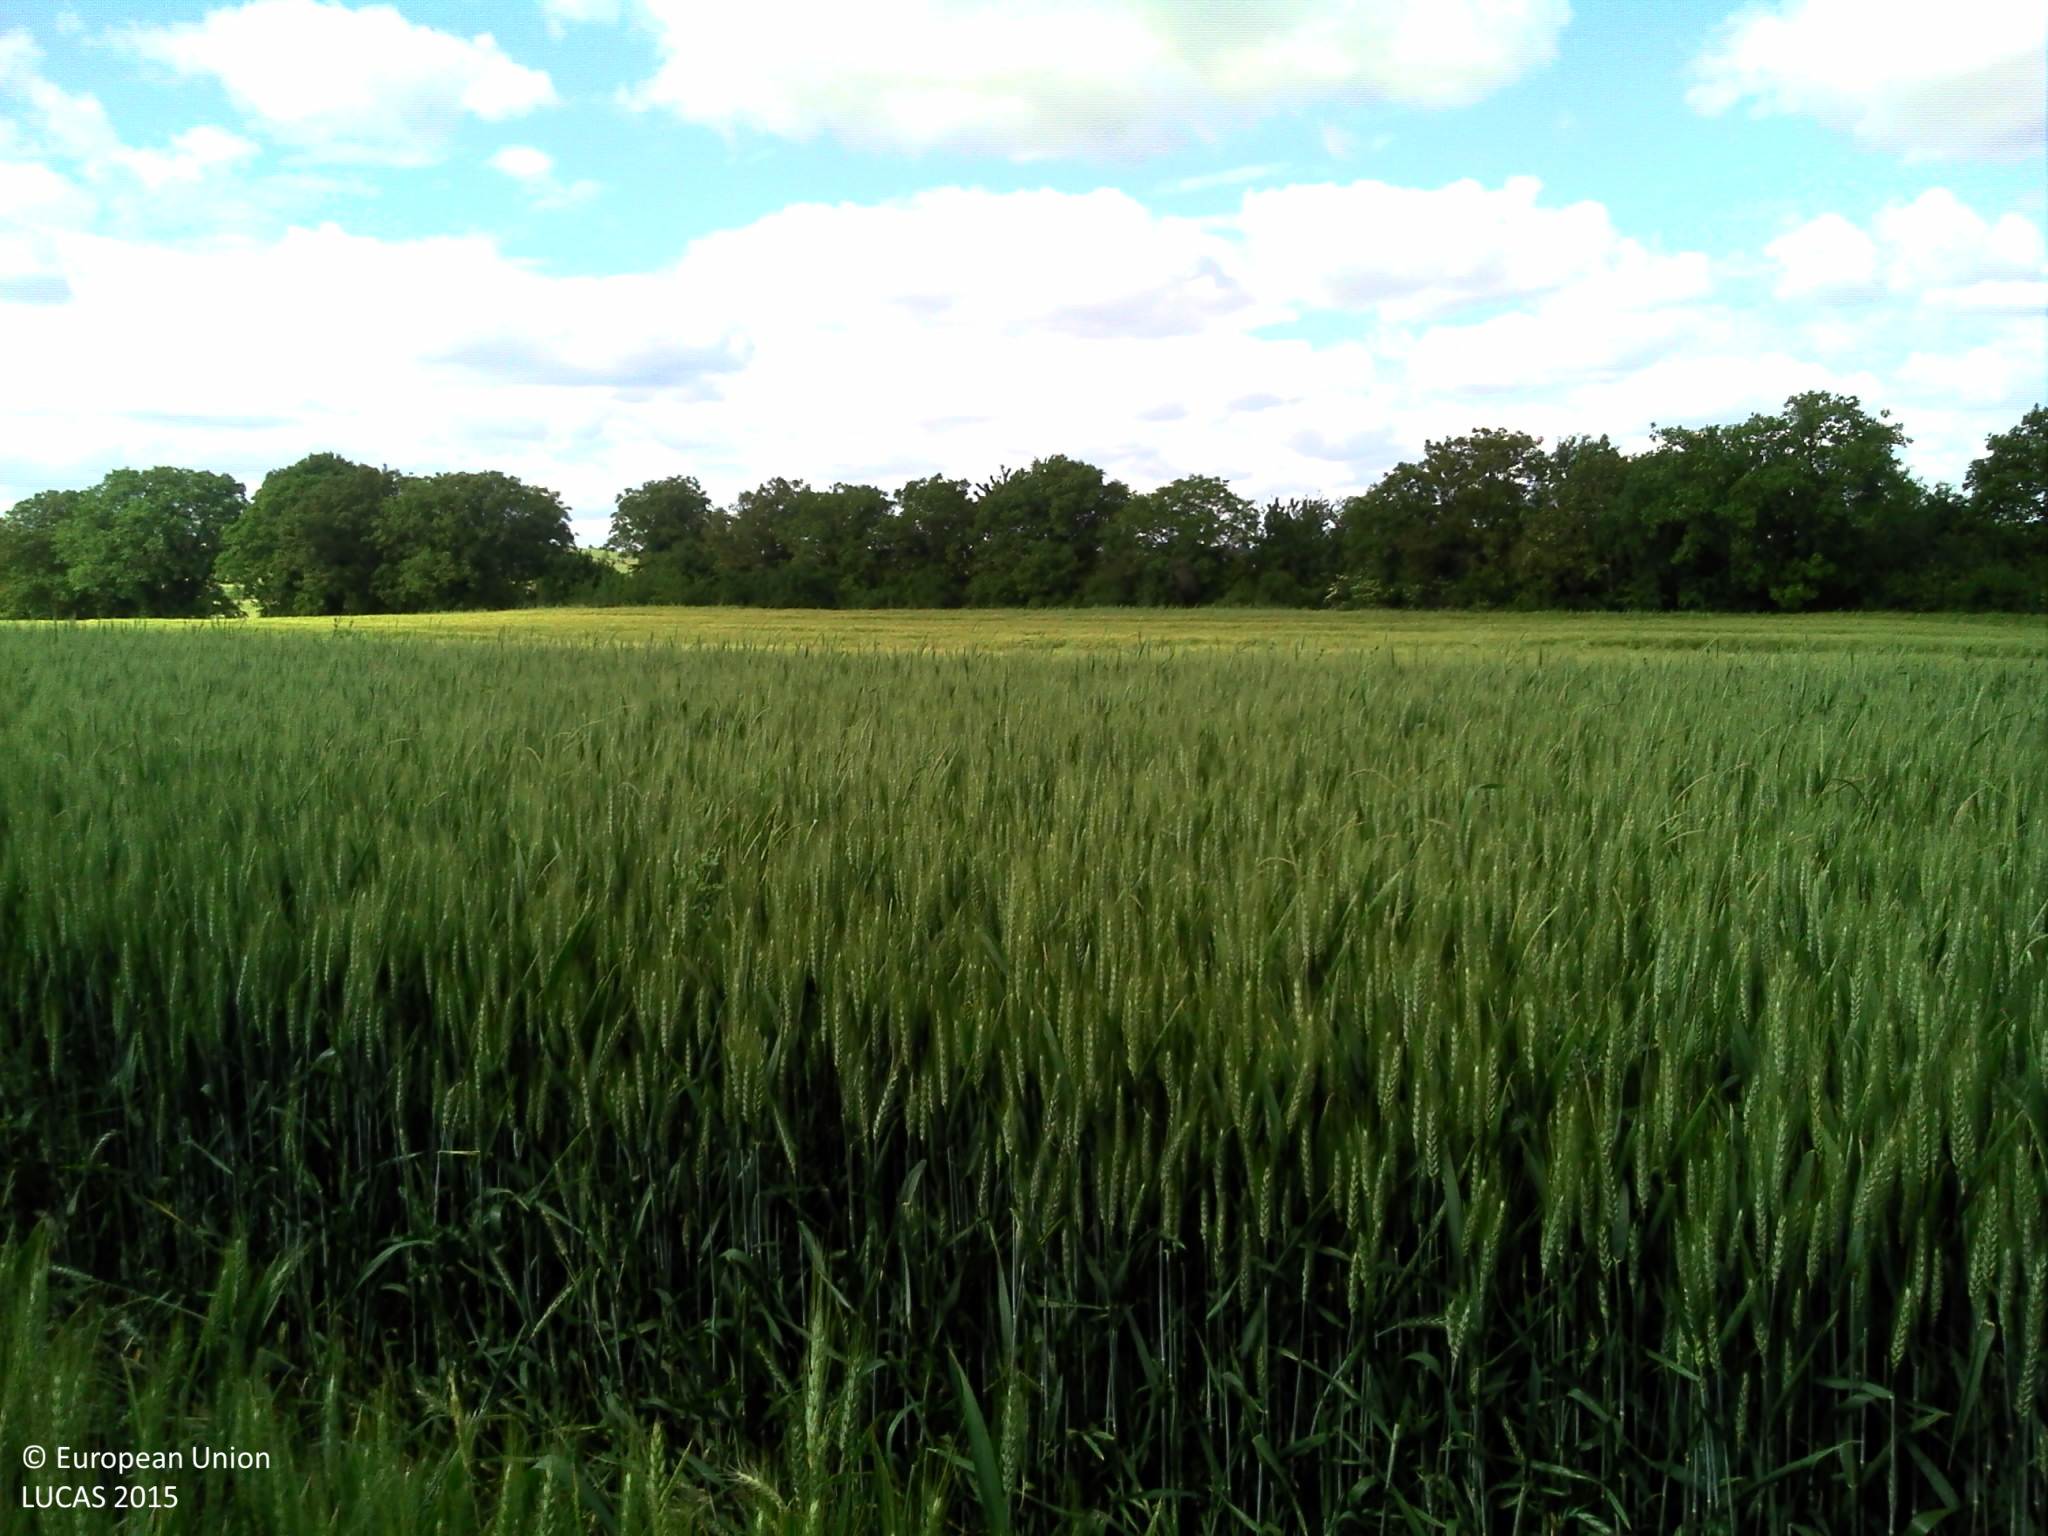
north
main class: Cropland
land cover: Common wheat
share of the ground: > 75 %
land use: Agriculture (excluding fallow land and kitchen gardens)
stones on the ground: < 10 %
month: May
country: FR
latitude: 46.7704
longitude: 0.1967
